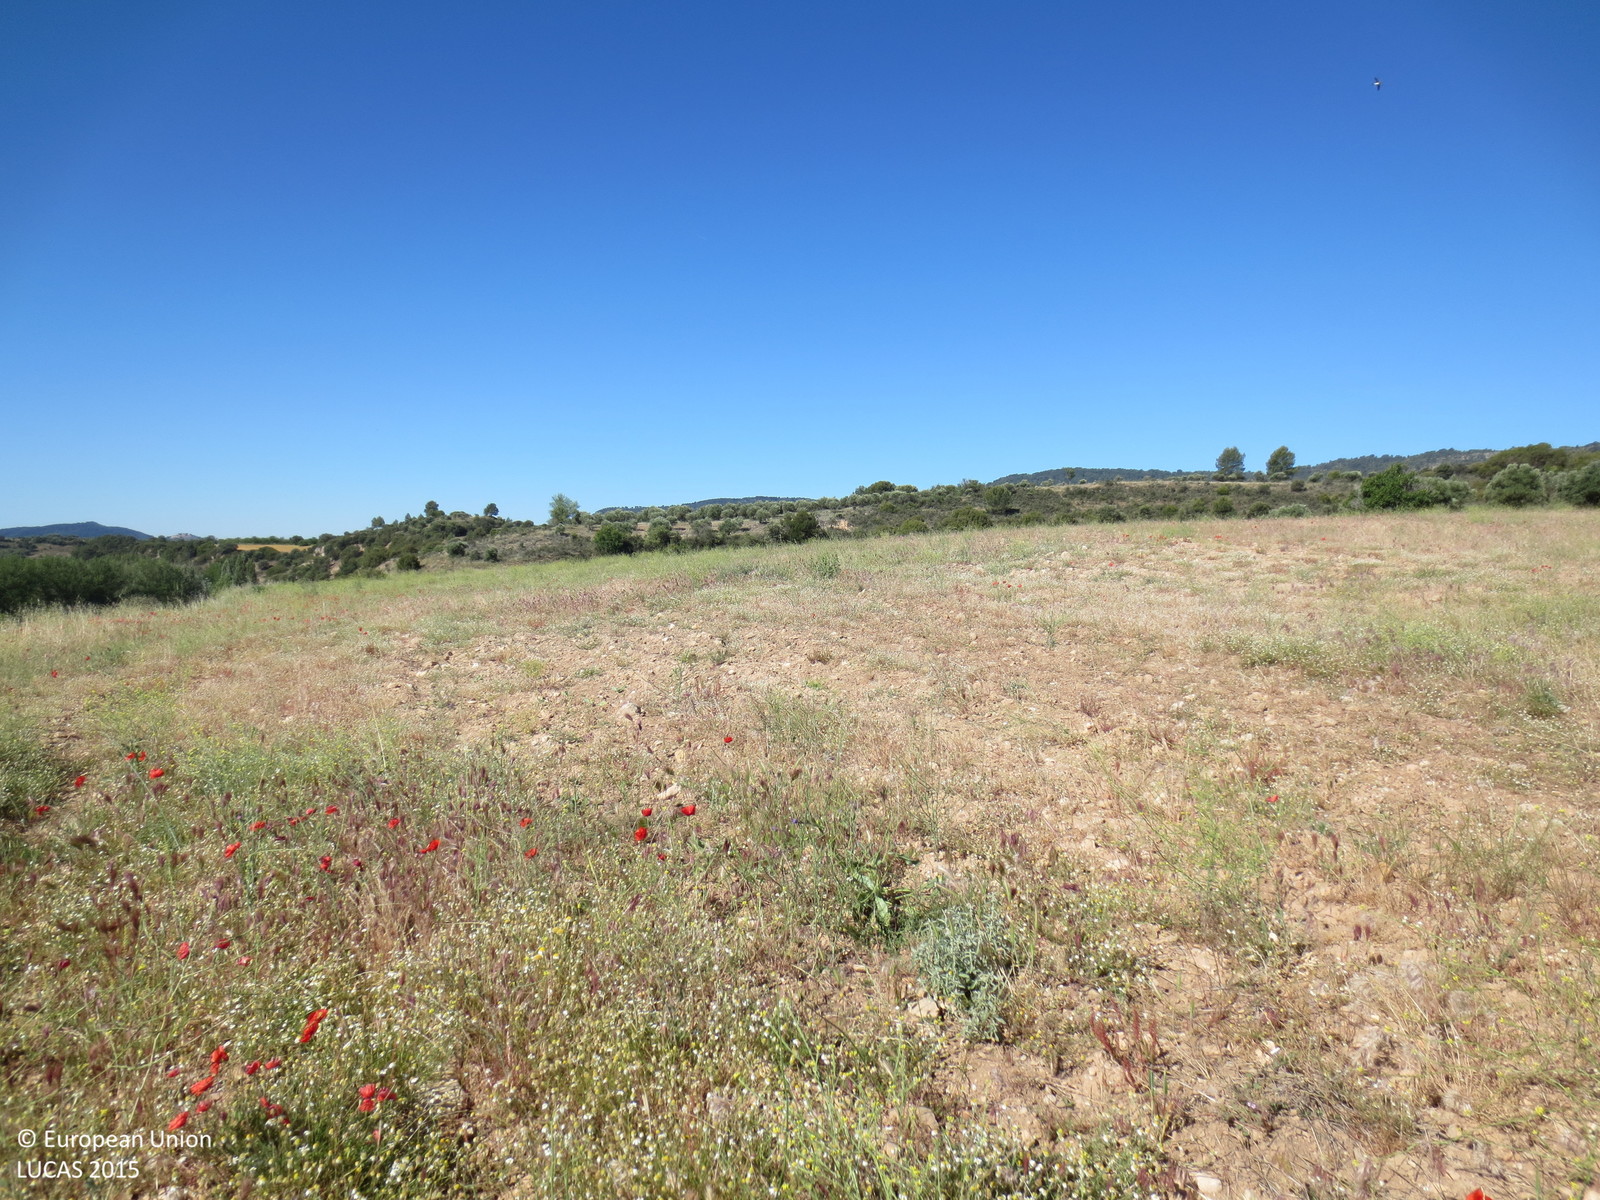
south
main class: Grassland
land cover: Spontaneously vegetated surfaces
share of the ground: 50 - 75 %
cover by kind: herbaceous plants 60 %, unconsolidated bare surface 40 %
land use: Fallow land
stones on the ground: > 50 %
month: May
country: ES
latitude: 40.4885
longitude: -2.7806
